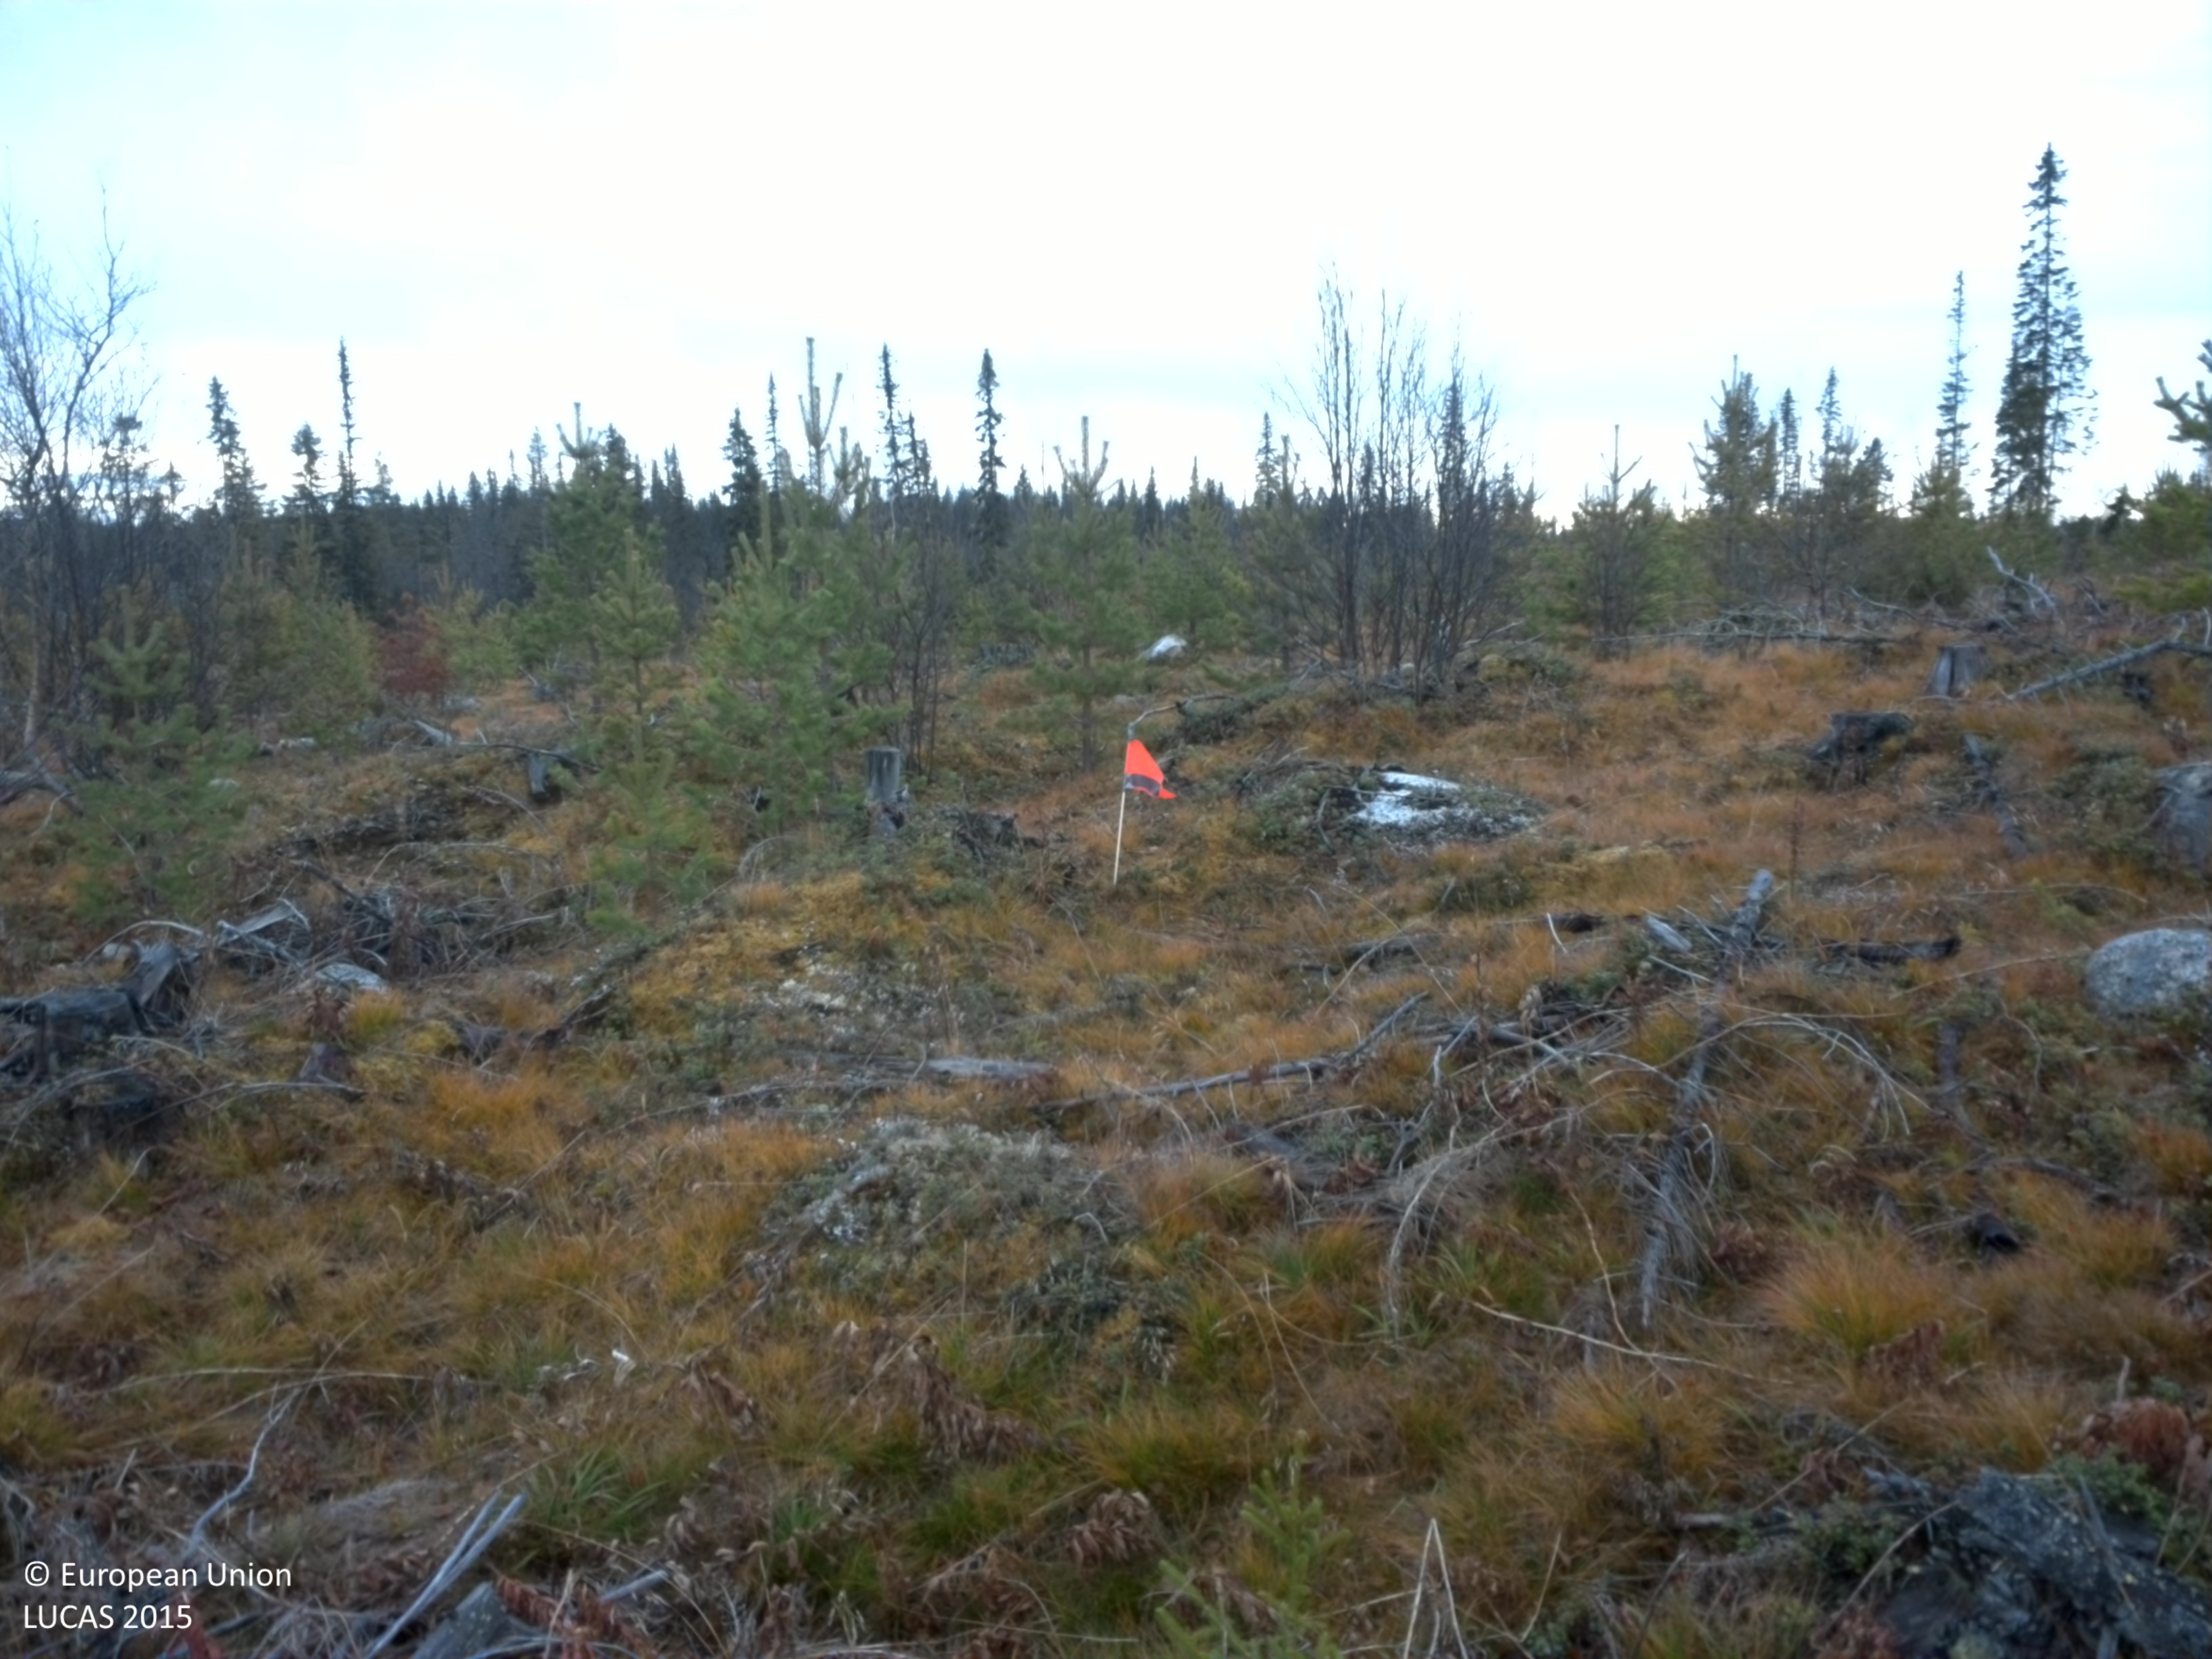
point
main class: Woodland
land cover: Pine dominated mixed woodland
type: boreal forest
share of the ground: 10 - 25 %
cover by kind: herbaceous plants 50 %, shrubs 20 %, lichens and mosses 20 %, coniferous forest trees 5 %, broadleaved forest trees 5 %
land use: Forestry
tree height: < 5 m
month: October
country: SE
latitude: 64.5157
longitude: 17.4035
